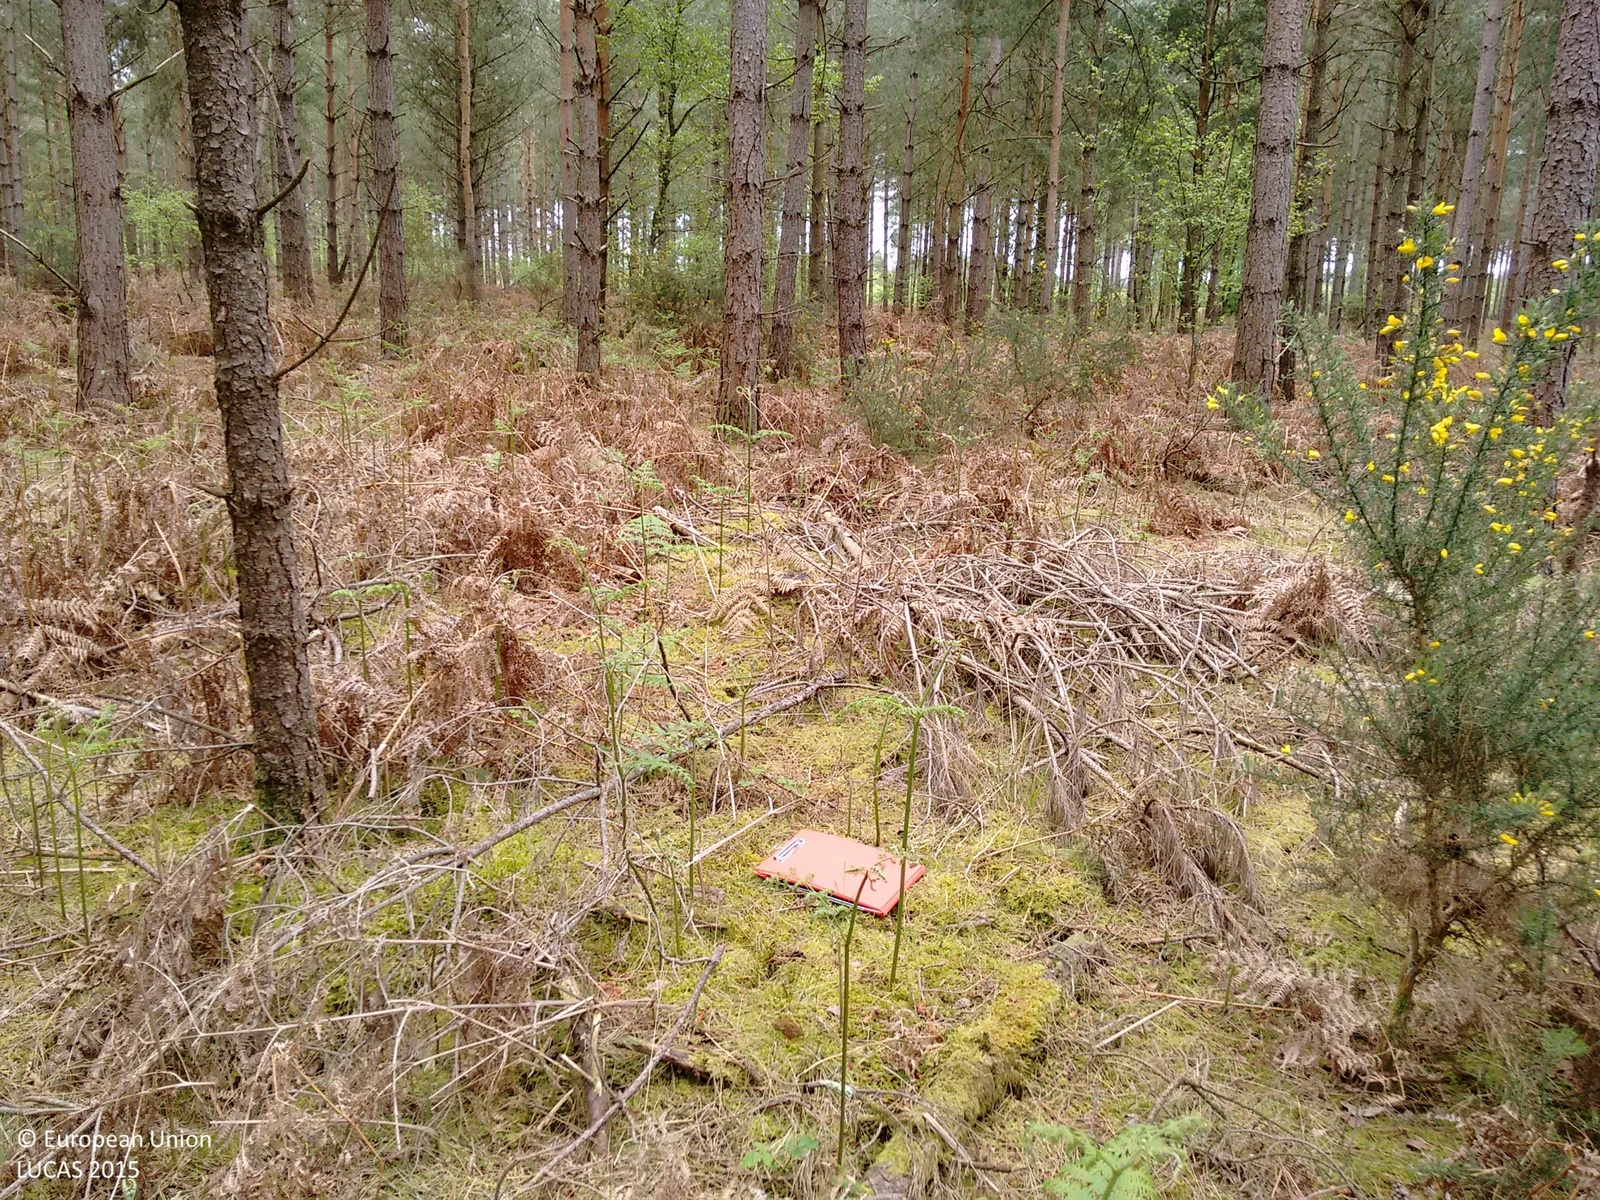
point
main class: Woodland
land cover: Pine dominated coniferous woodland
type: hemiboreal forest and nemoral coniferous forest and mixed broadleaved-coniferous forest
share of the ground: > 75 %
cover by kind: coniferous forest trees 100 %
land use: Forestry
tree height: > 5 m
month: May
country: GB
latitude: 50.8002
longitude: -1.8467
